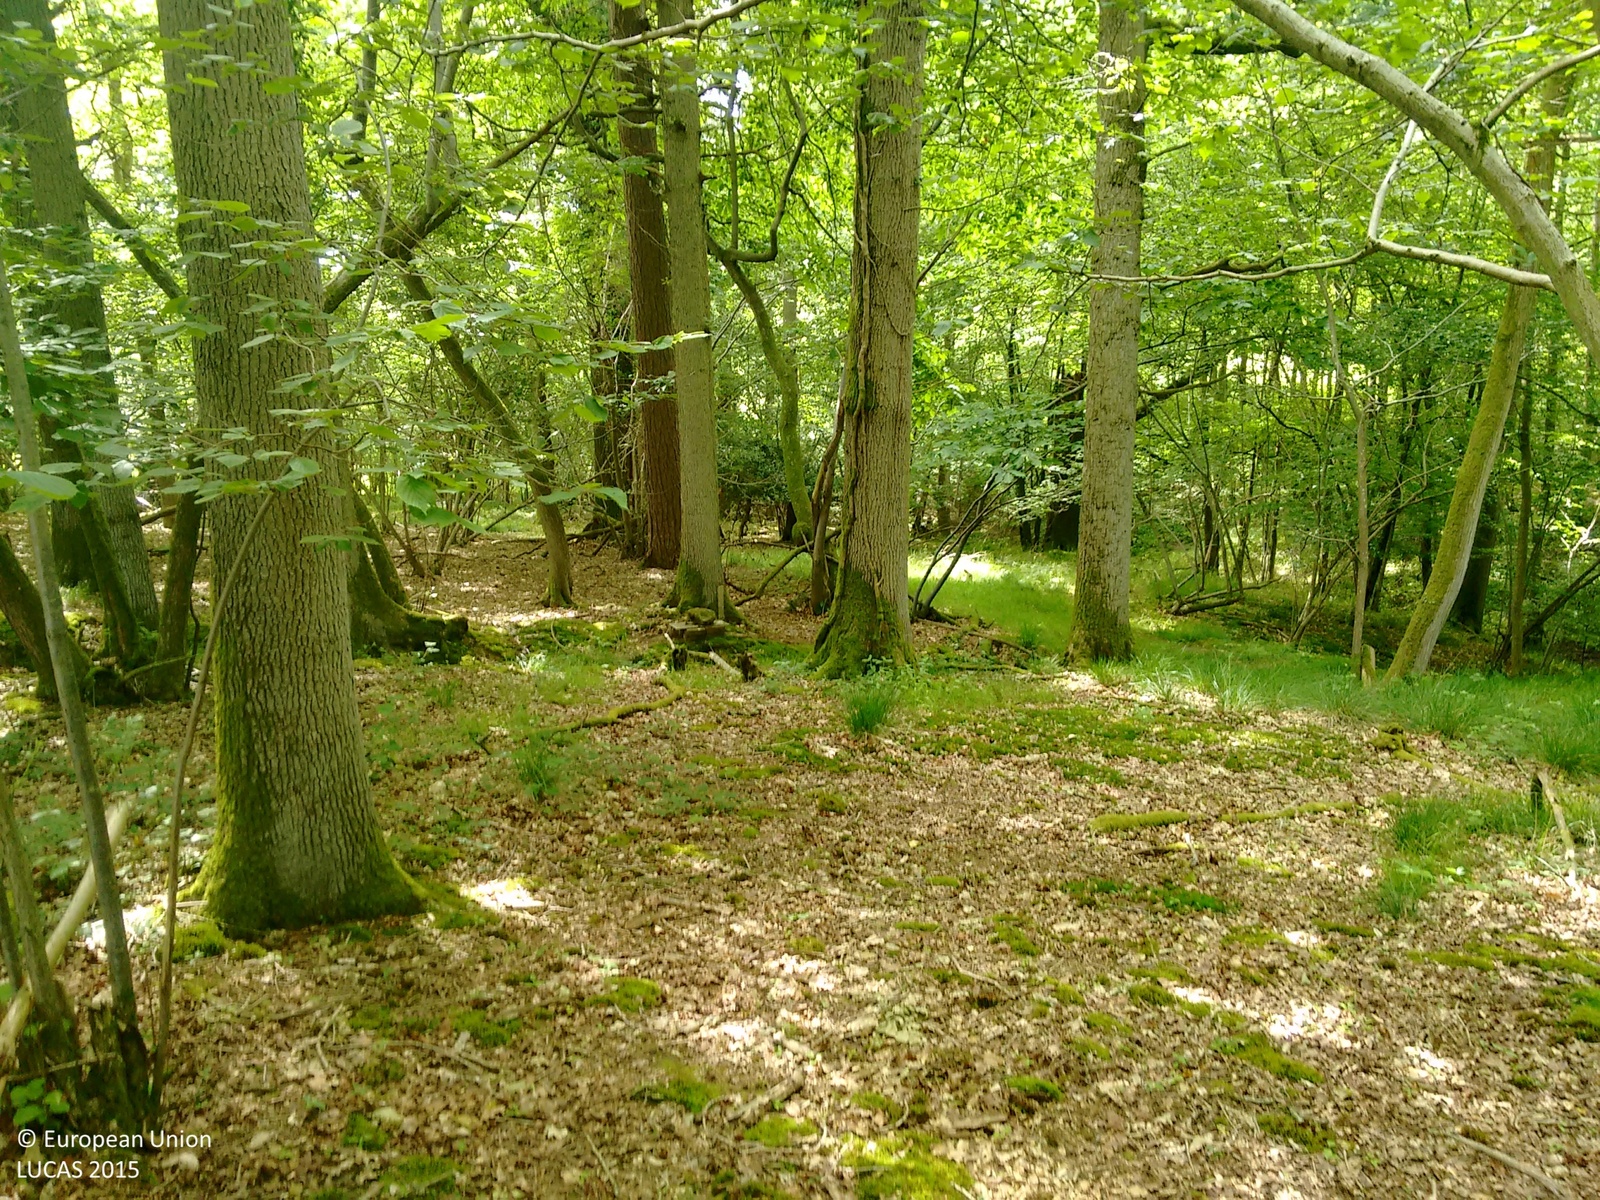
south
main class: Woodland
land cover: Broadleaved woodland
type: mesophytic deciduous forest
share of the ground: > 75 %
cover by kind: broadleaved forest trees 90 %, shrubs 10 %
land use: Forestry
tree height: > 5 m
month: June
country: GB
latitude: 51.0939
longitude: -0.1003
